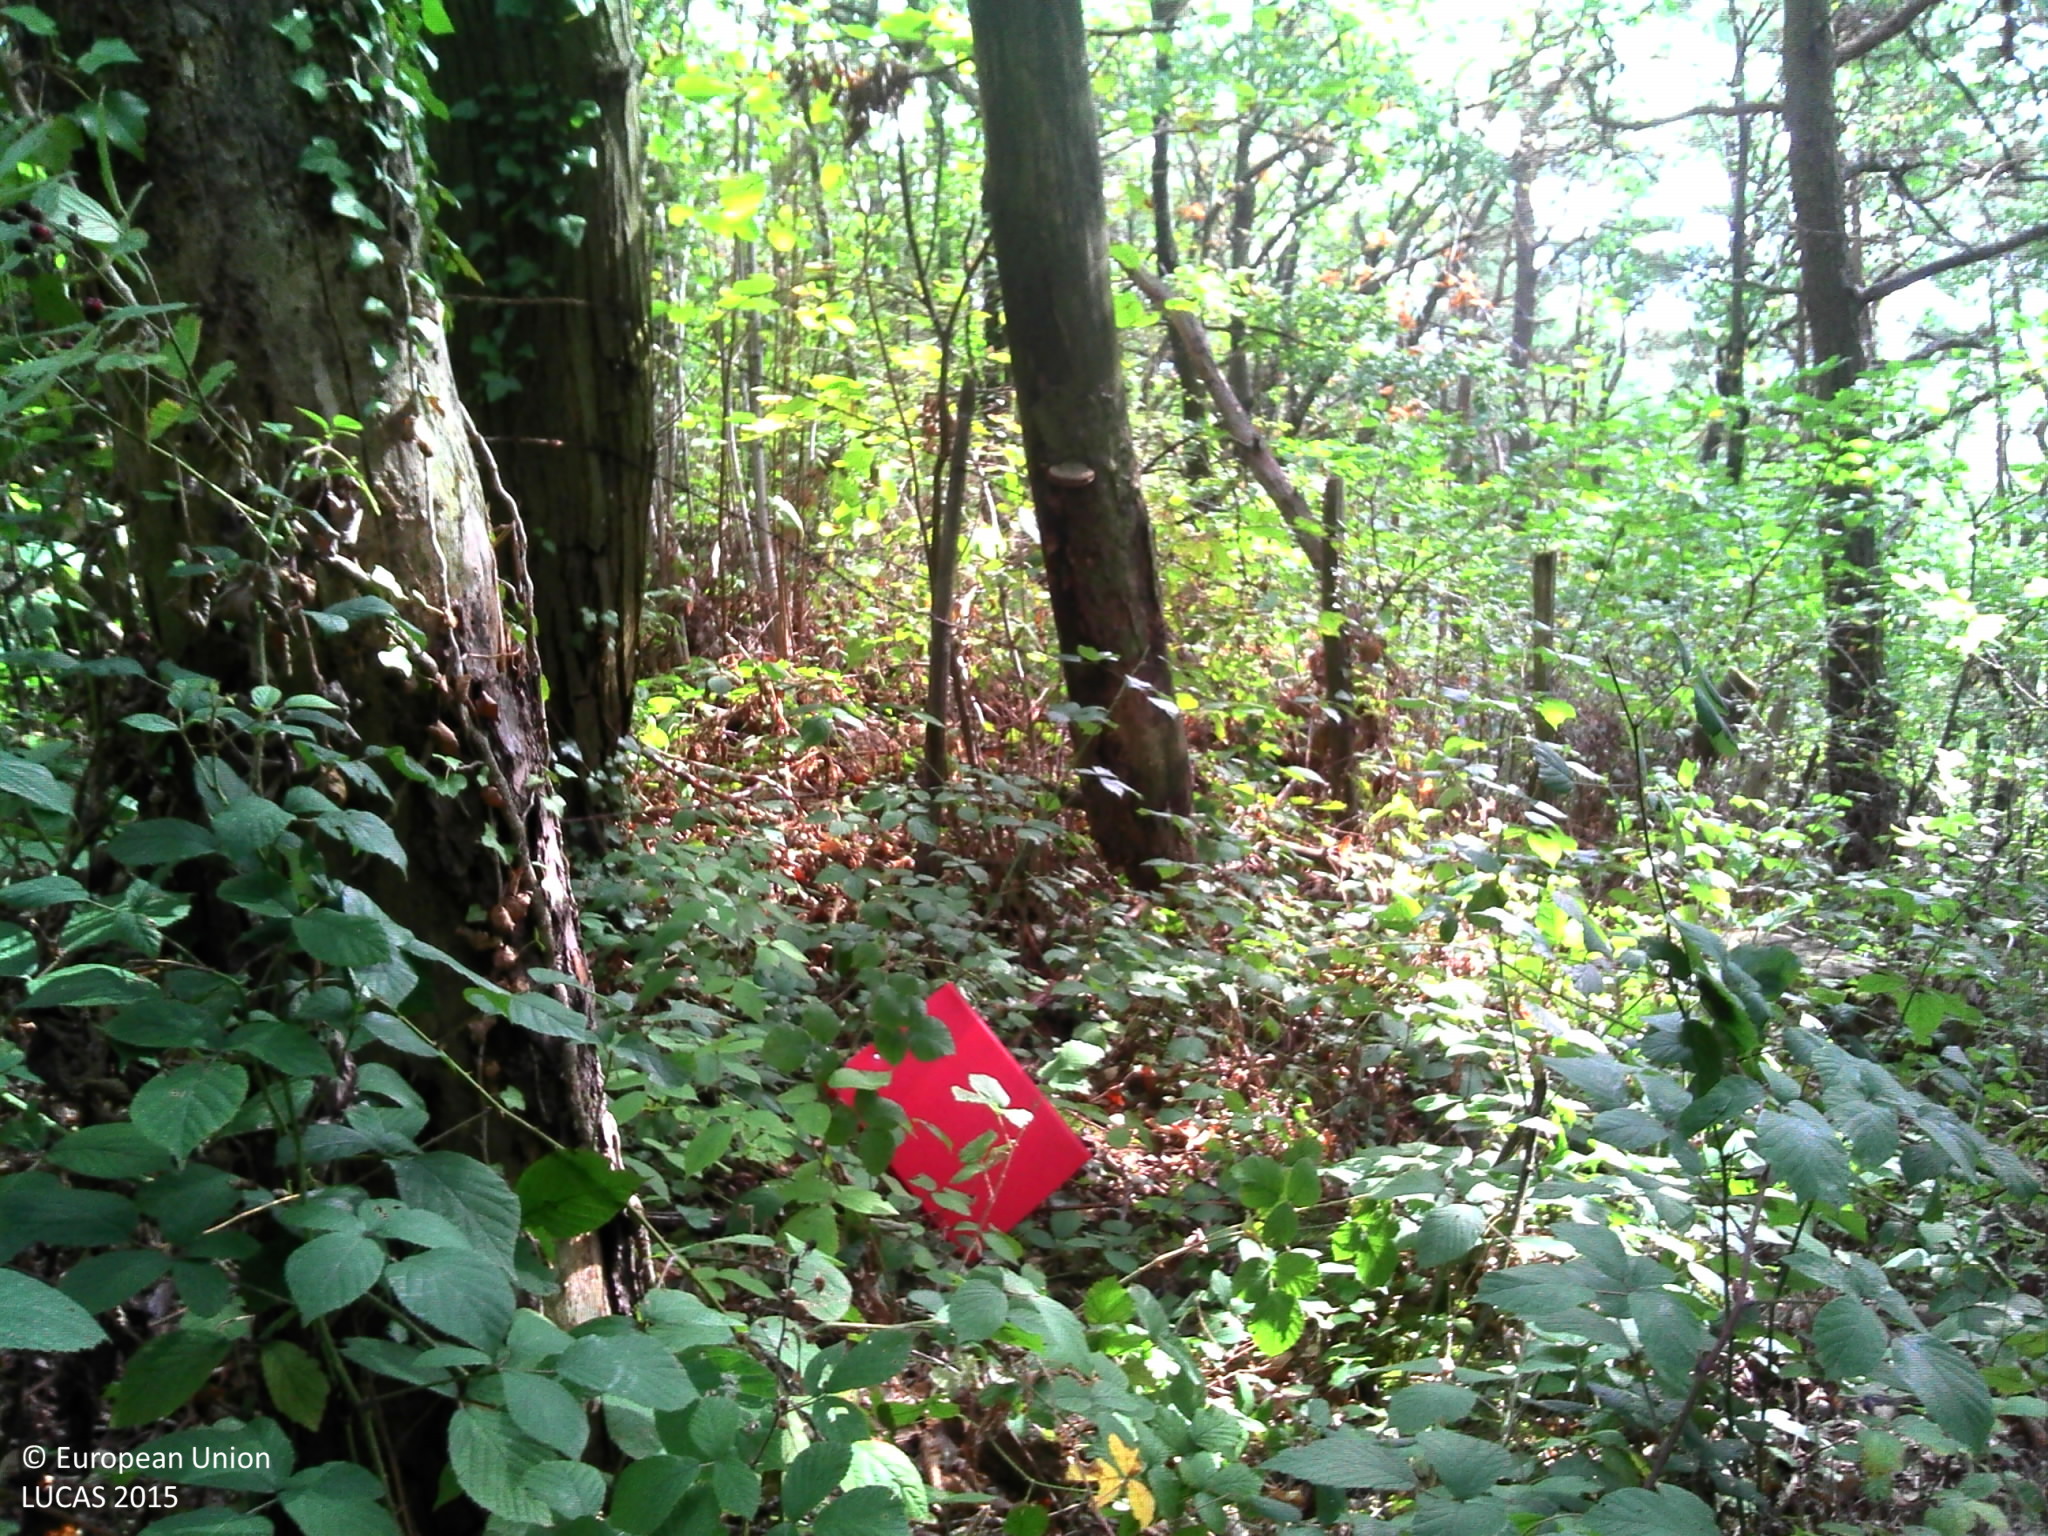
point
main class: Woodland
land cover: Broadleaved woodland
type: mesophytic deciduous forest
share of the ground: > 75 %
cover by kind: broadleaved forest trees 90 %, herbaceous plants 5 %, lichens and mosses 5 %
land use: Forestry
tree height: > 5 m
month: October
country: FR
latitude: 45.6385
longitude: 4.6282
